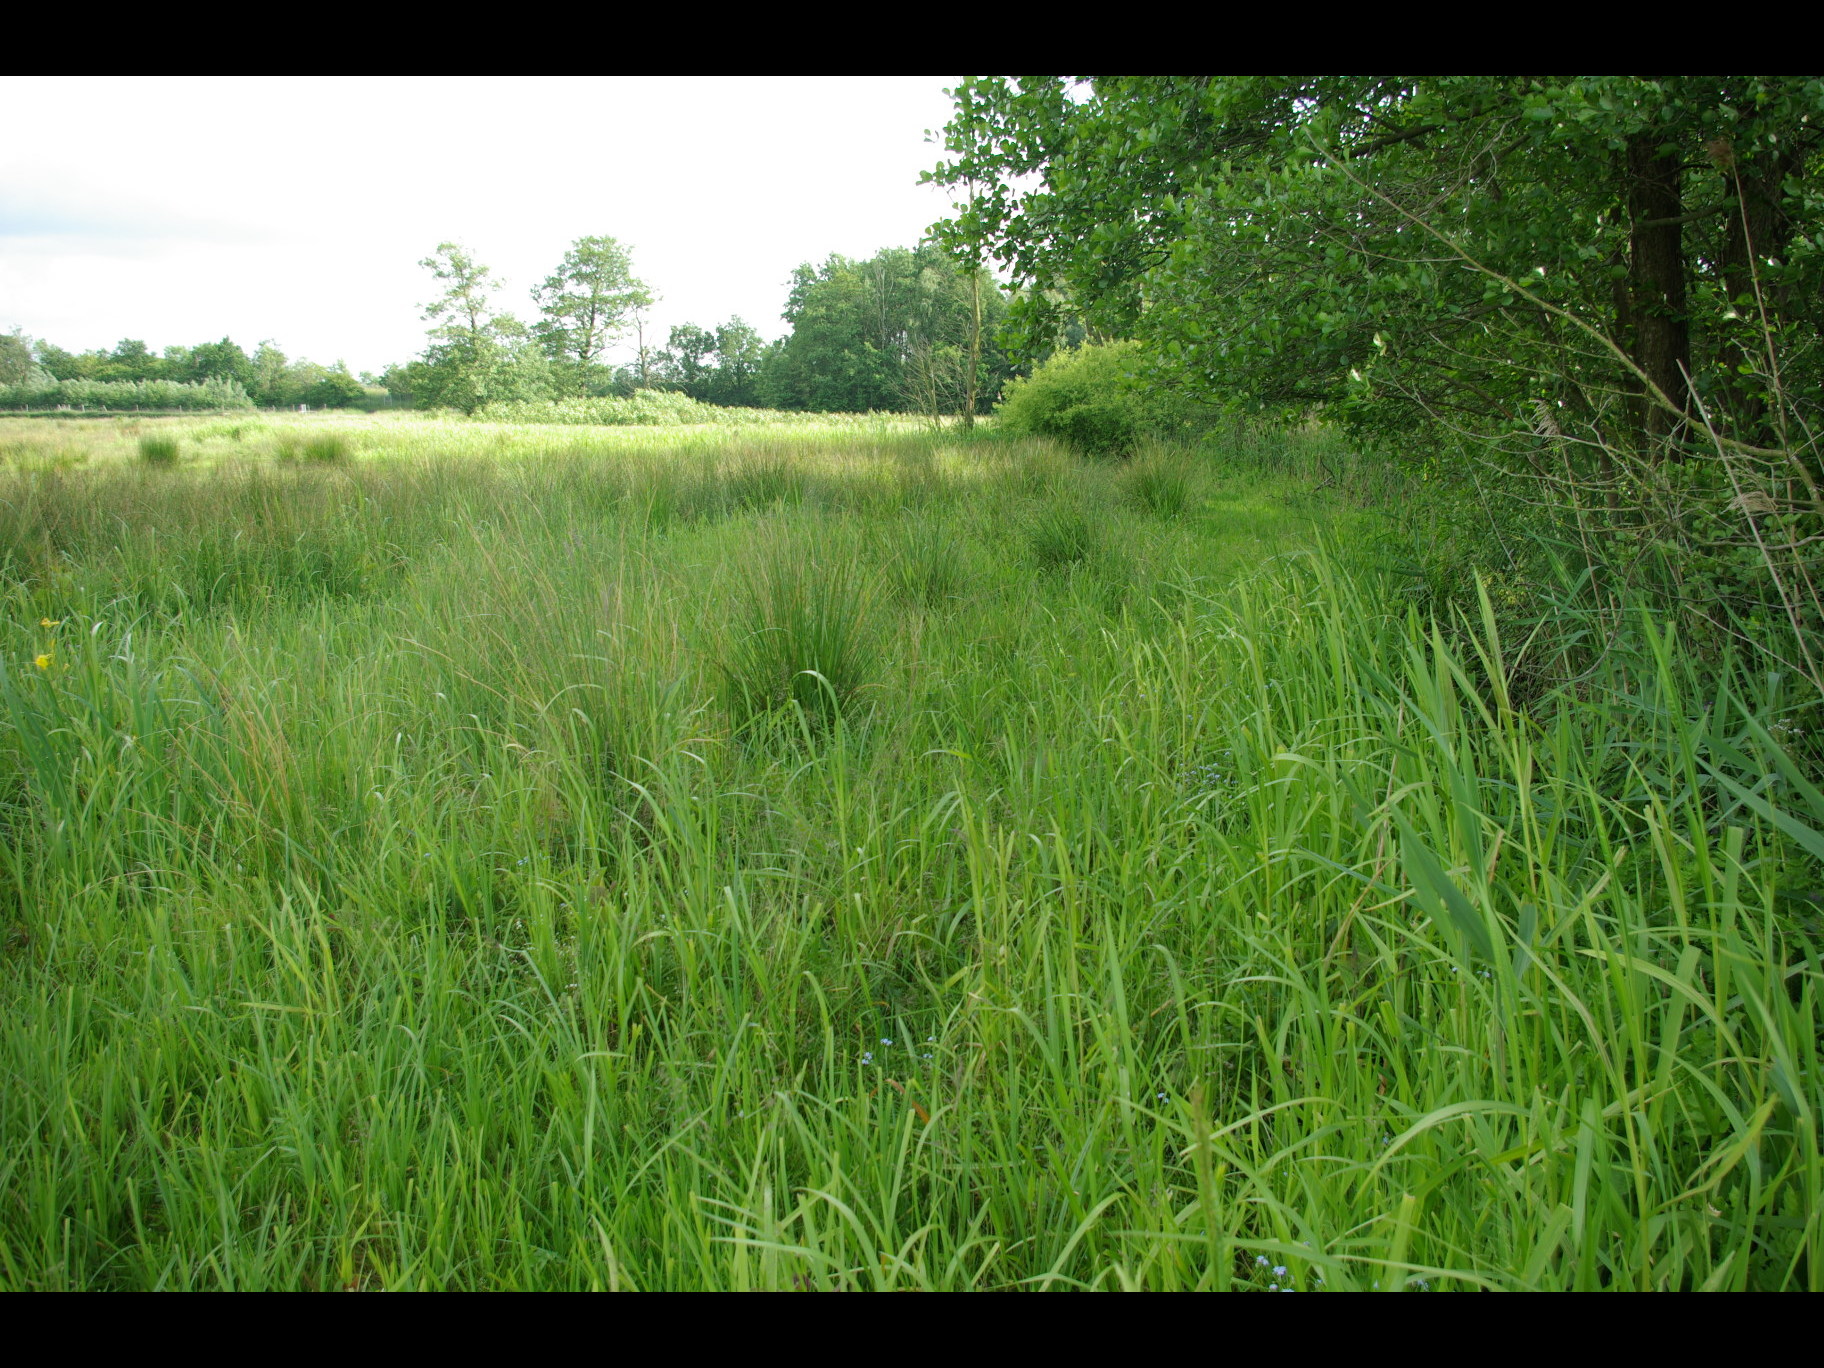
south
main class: Woodland
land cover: Broadleaved woodland
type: mire and swamp forests
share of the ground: > 75 %
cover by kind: broadleaved forest trees 60 %, herbaceous plants 30 %, shrubs 10 %
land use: Semi-natural and natural areas not in use
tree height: > 5 m
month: June
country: DE
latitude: 54.1927
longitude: 9.9234
